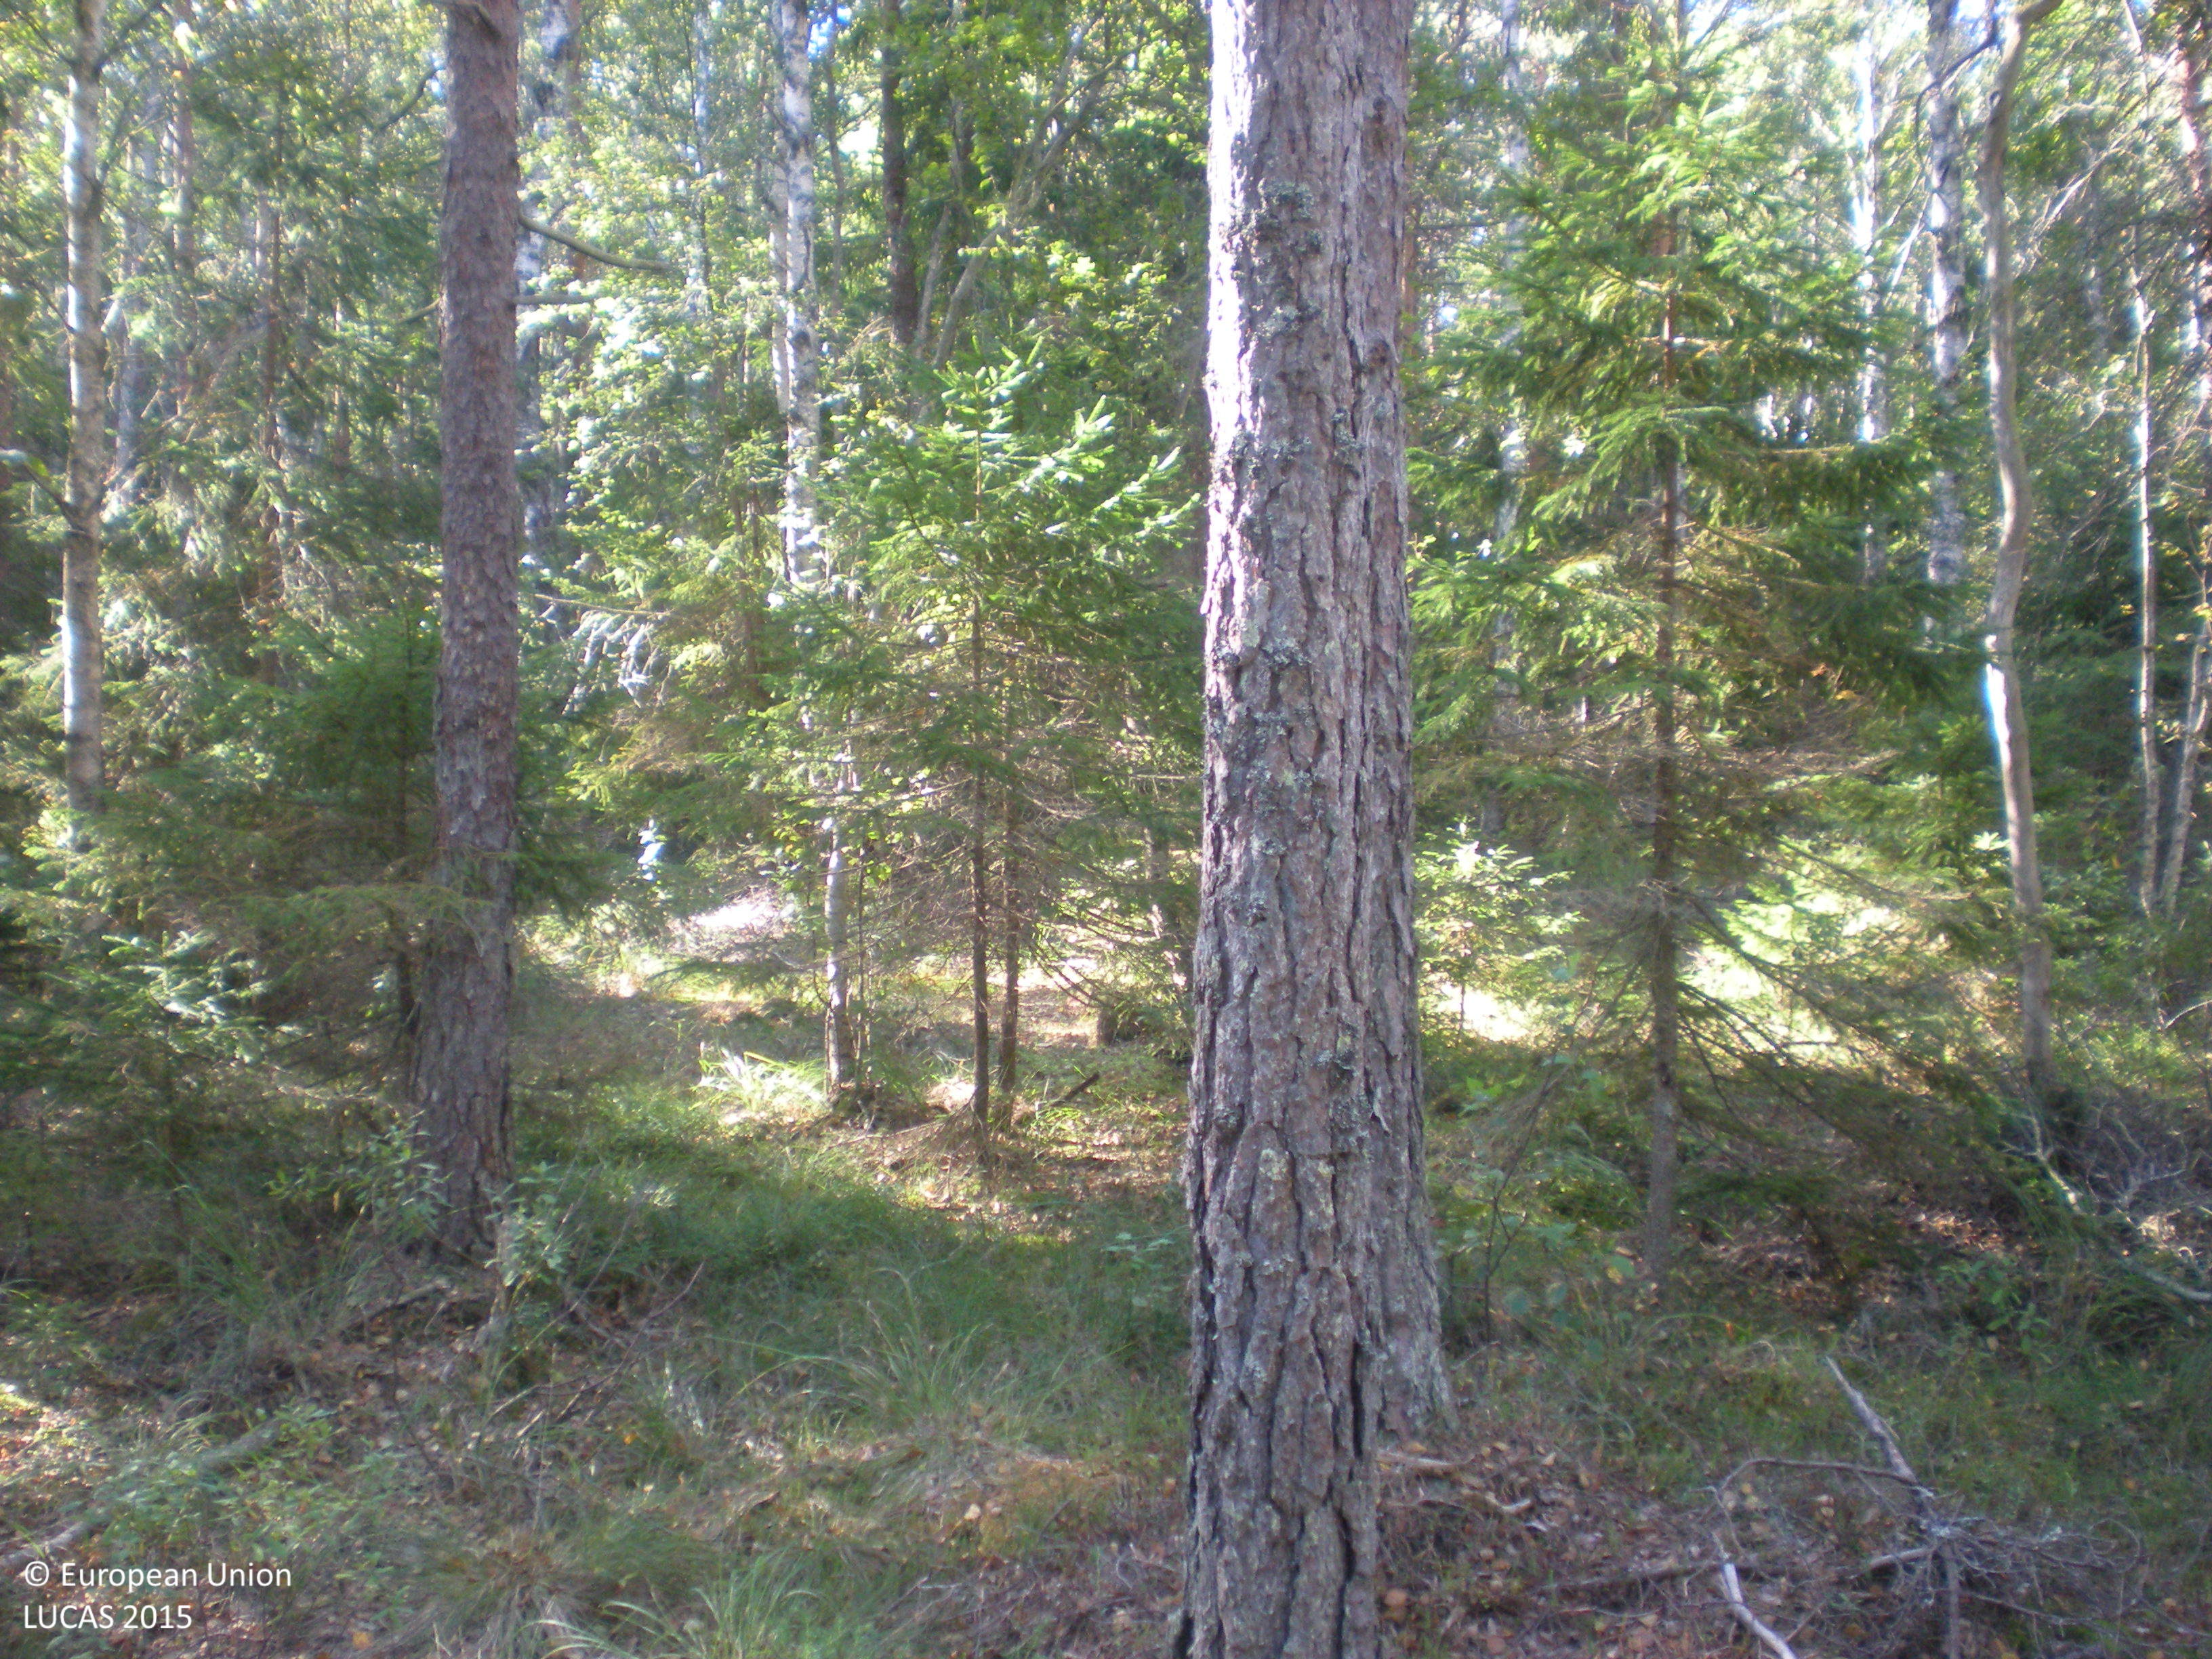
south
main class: Woodland
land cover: Pine dominated mixed woodland
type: boreal forest
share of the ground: 50 - 75 %
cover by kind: coniferous forest trees 40 %, broadleaved forest trees 25 %, herbaceous plants 15 %, lichens and mosses 10 %, shrubs 5 %
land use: Forestry
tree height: > 5 m
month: August
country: SE
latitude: 60.5775
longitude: 17.1614
